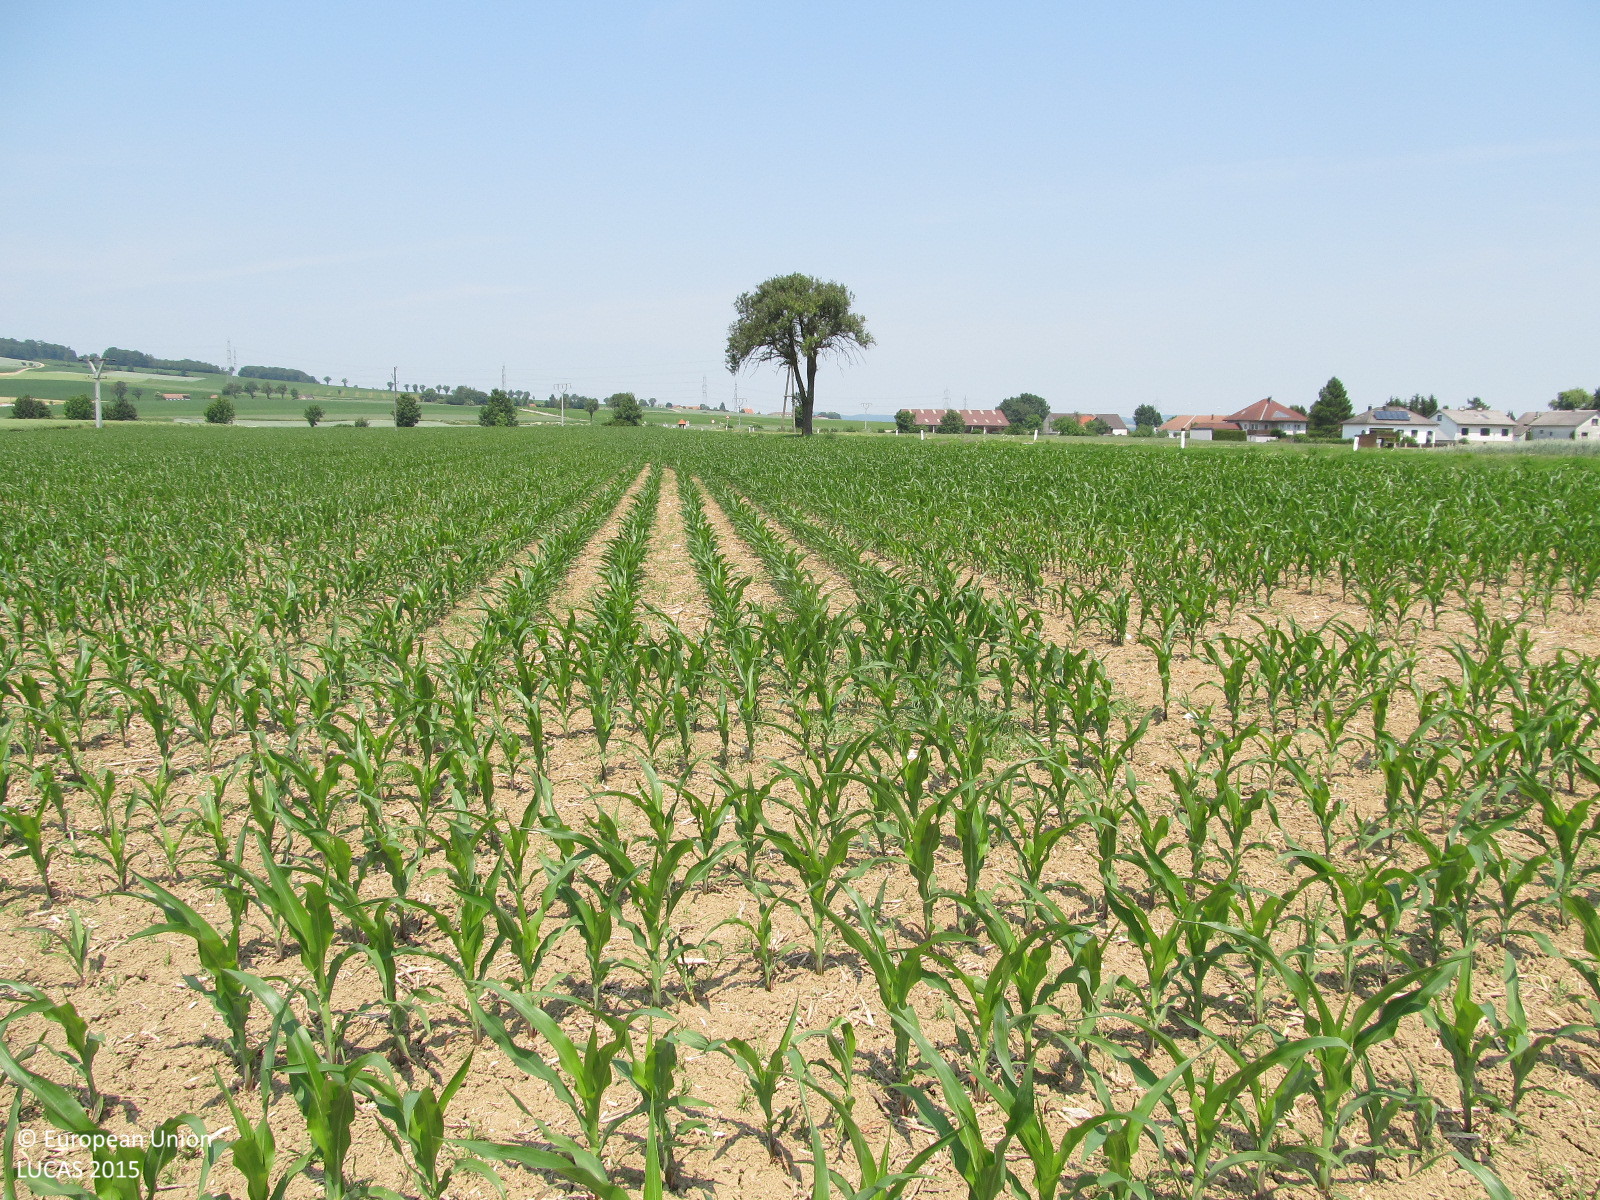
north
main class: Cropland
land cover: Maize
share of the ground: 25 - 50 %
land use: Agriculture (excluding fallow land and kitchen gardens)
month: June
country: AT
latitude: 48.2427
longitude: 15.6179
